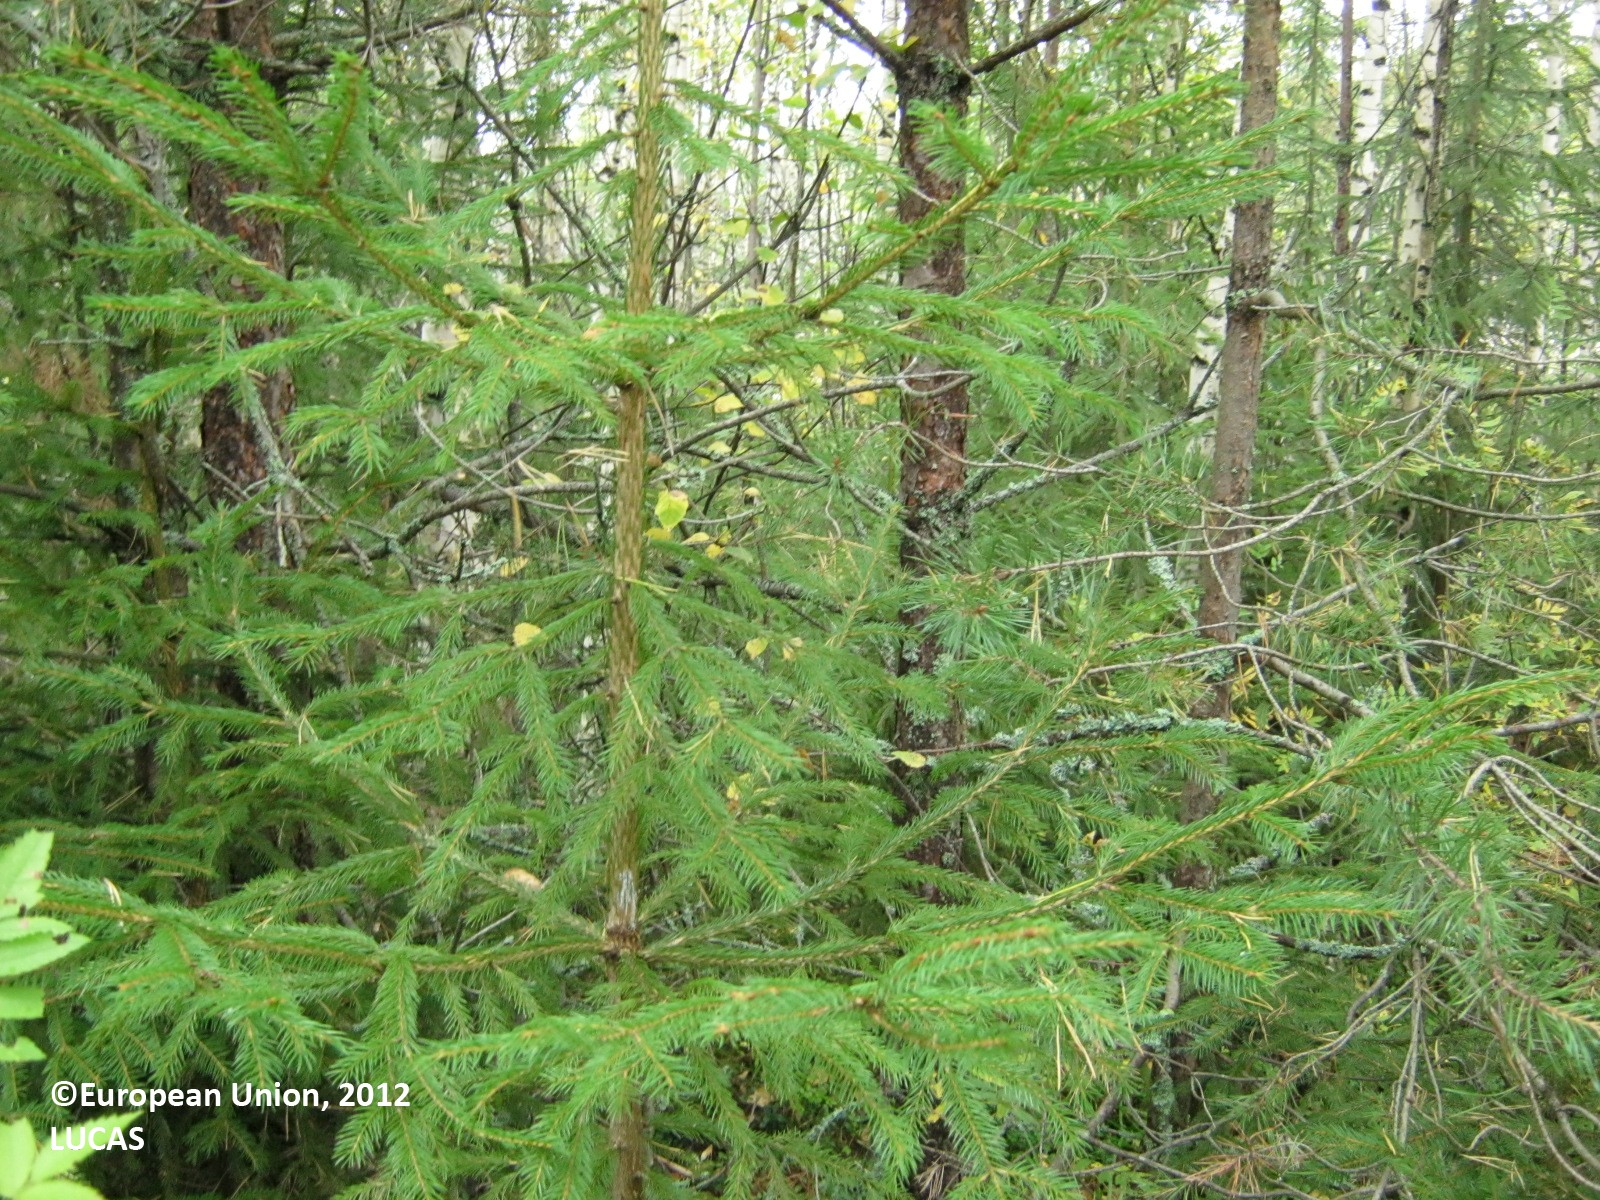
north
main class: Woodland
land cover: Spruce dominated mixed woodland
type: boreal forest
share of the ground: > 75 %
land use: Forestry
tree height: > 5 m
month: September
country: FI
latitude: 60.5716
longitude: 27.8032
